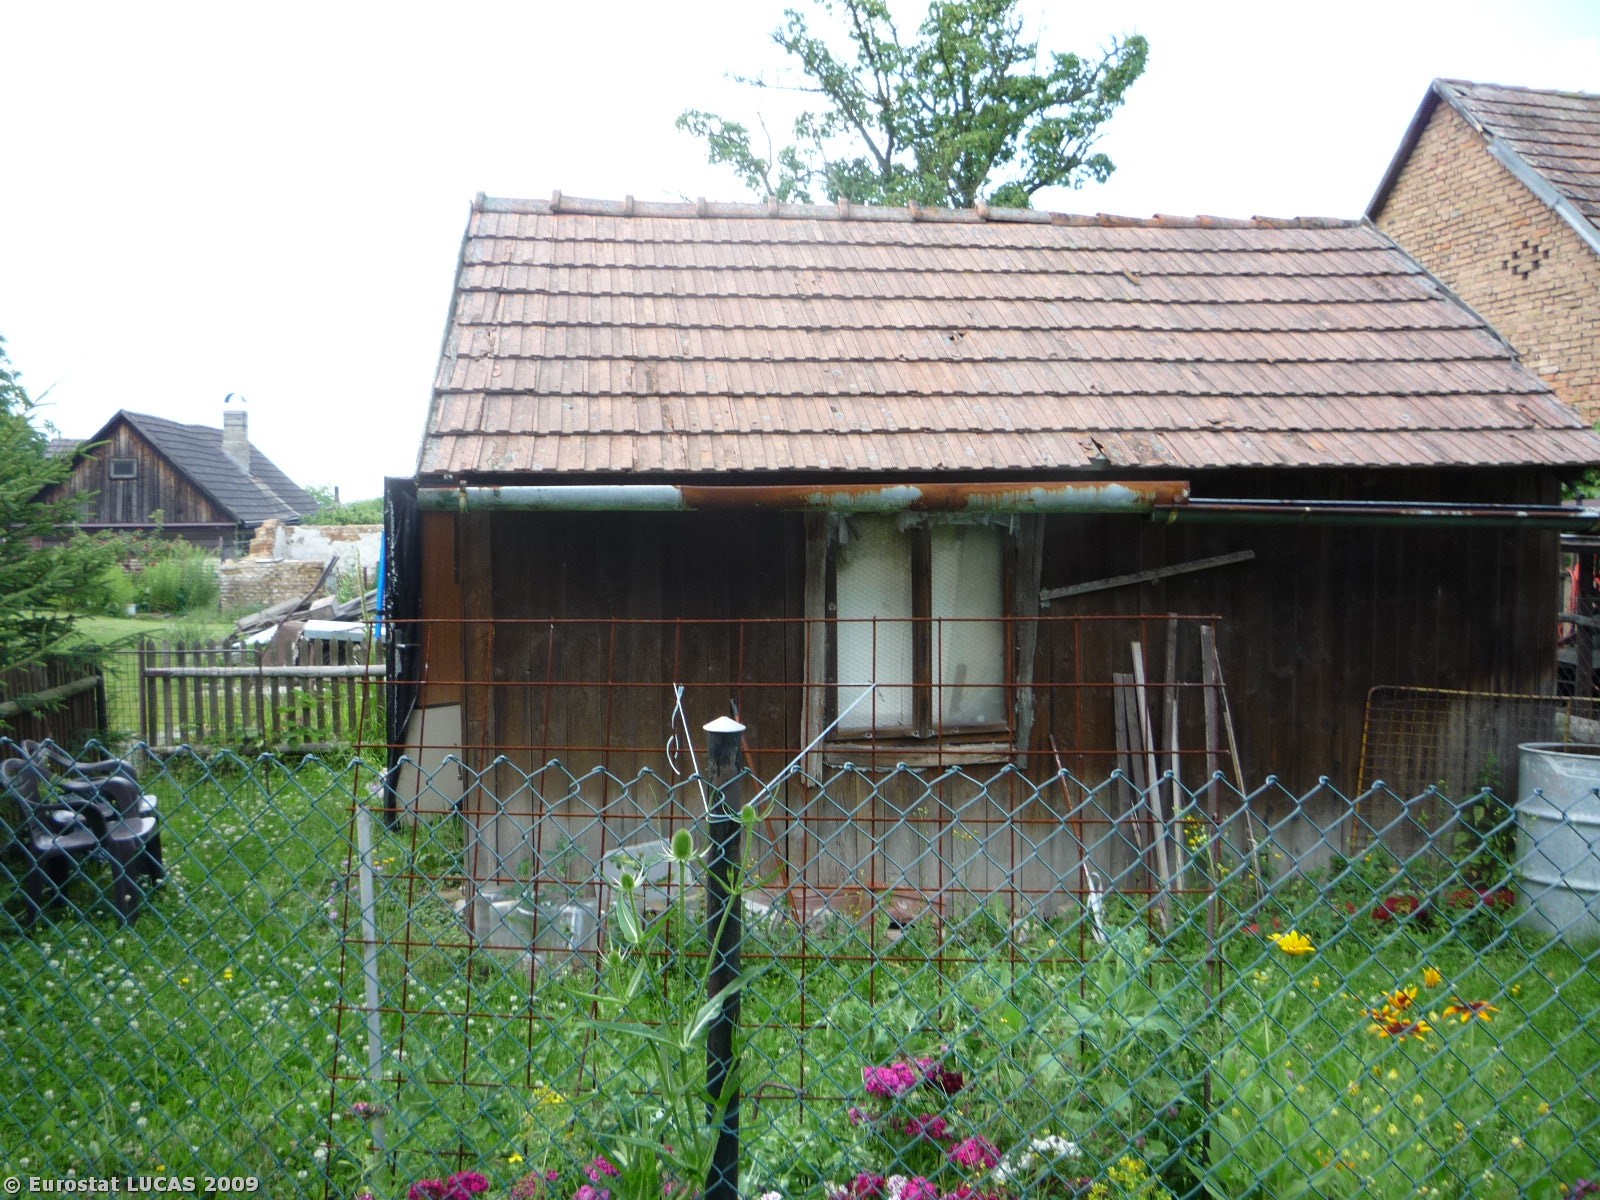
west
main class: Grassland
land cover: Grassland without tree/shrub cover
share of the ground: > 75 %
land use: Residential
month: June
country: CZ
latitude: 50.3261
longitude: 15.0175
